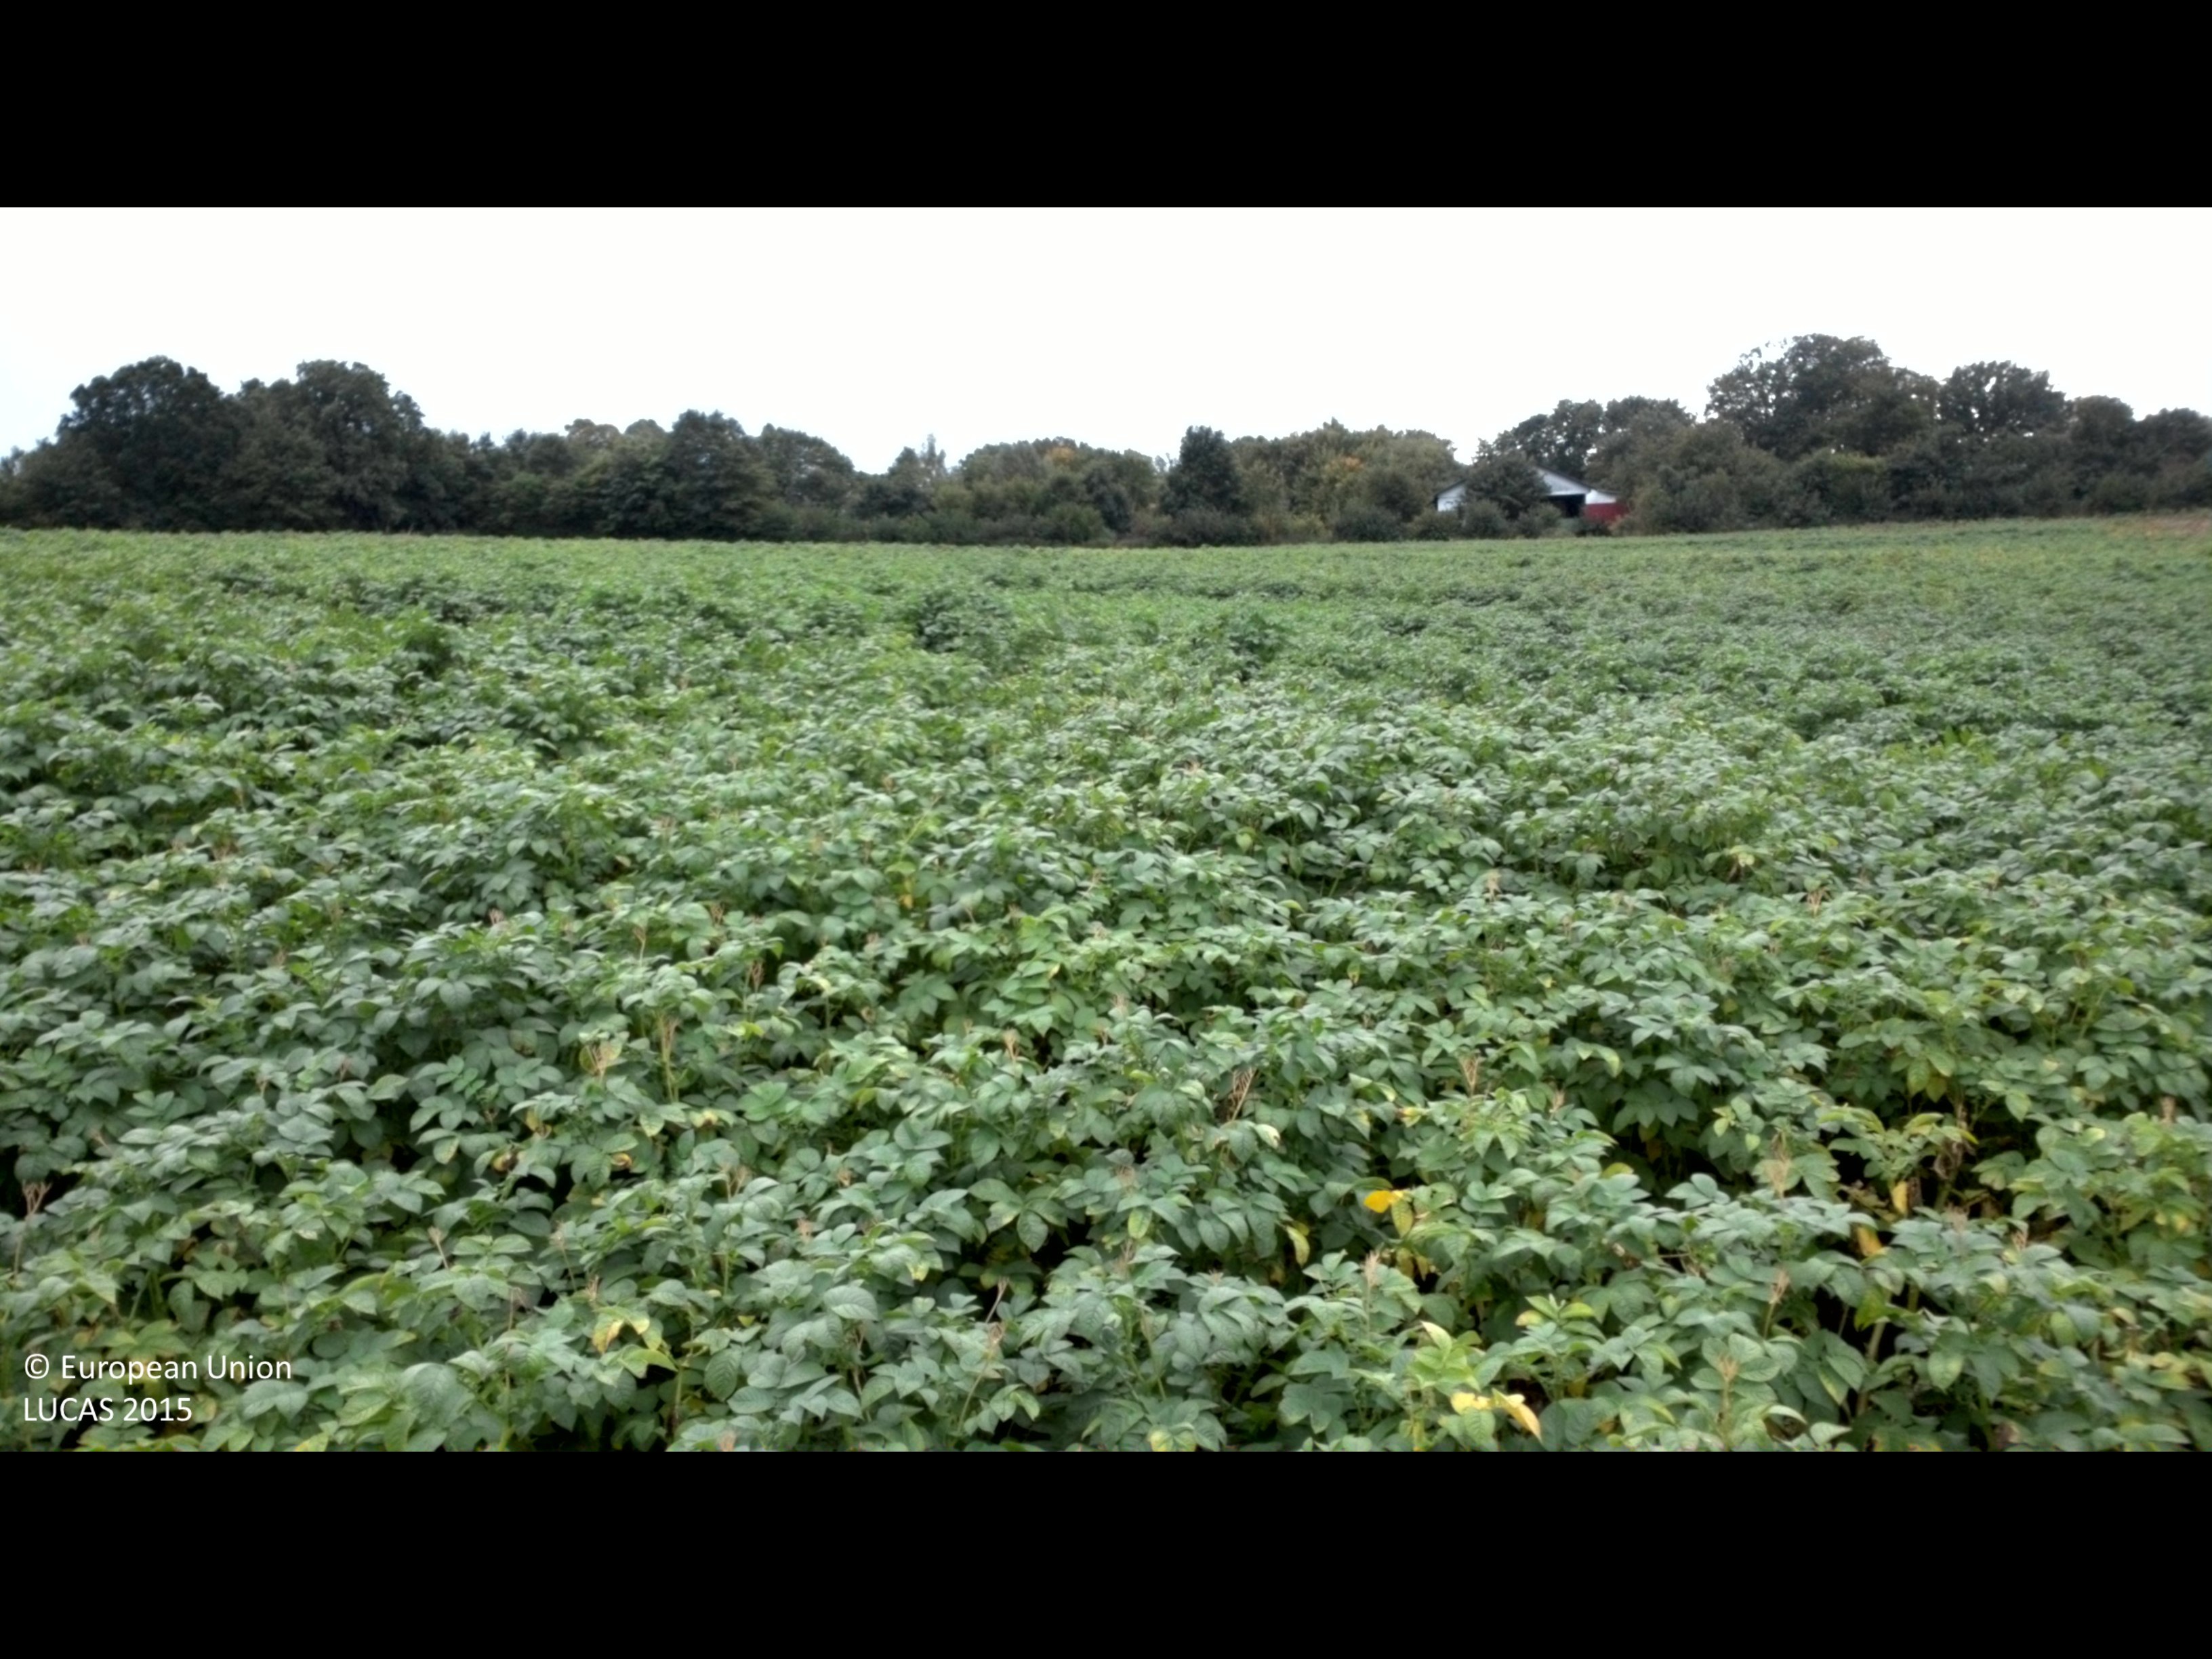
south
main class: Cropland
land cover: Potatoes
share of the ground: > 75 %
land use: Agriculture (excluding fallow land and kitchen gardens)
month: September
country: SE
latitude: 56.0915
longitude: 14.4825
